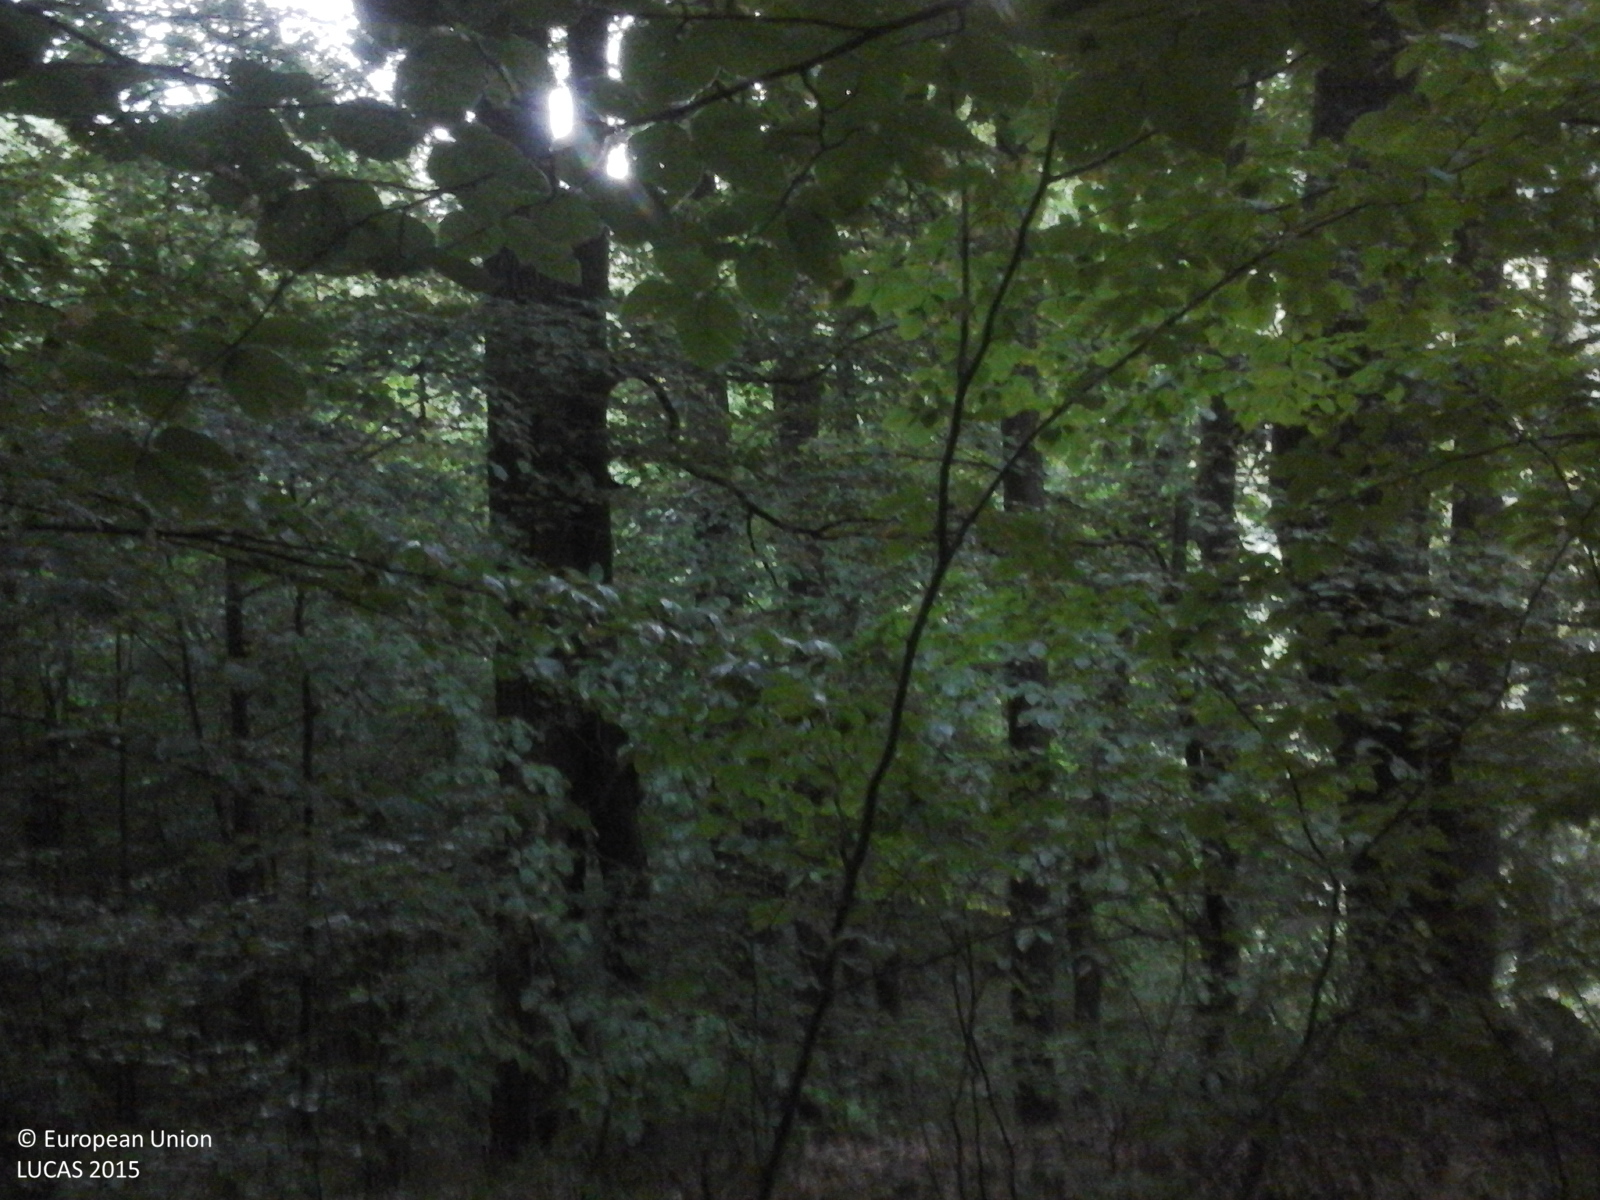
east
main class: Woodland
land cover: Broadleaved woodland
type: beech forest
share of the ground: > 75 %
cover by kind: broadleaved forest trees 100 %
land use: Forestry
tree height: > 5 m
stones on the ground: < 10 %
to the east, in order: Broadleaved woodland; Grassland with sparse tree/shrub cover
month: June
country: RO
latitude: 47.2356
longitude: 26.3163
